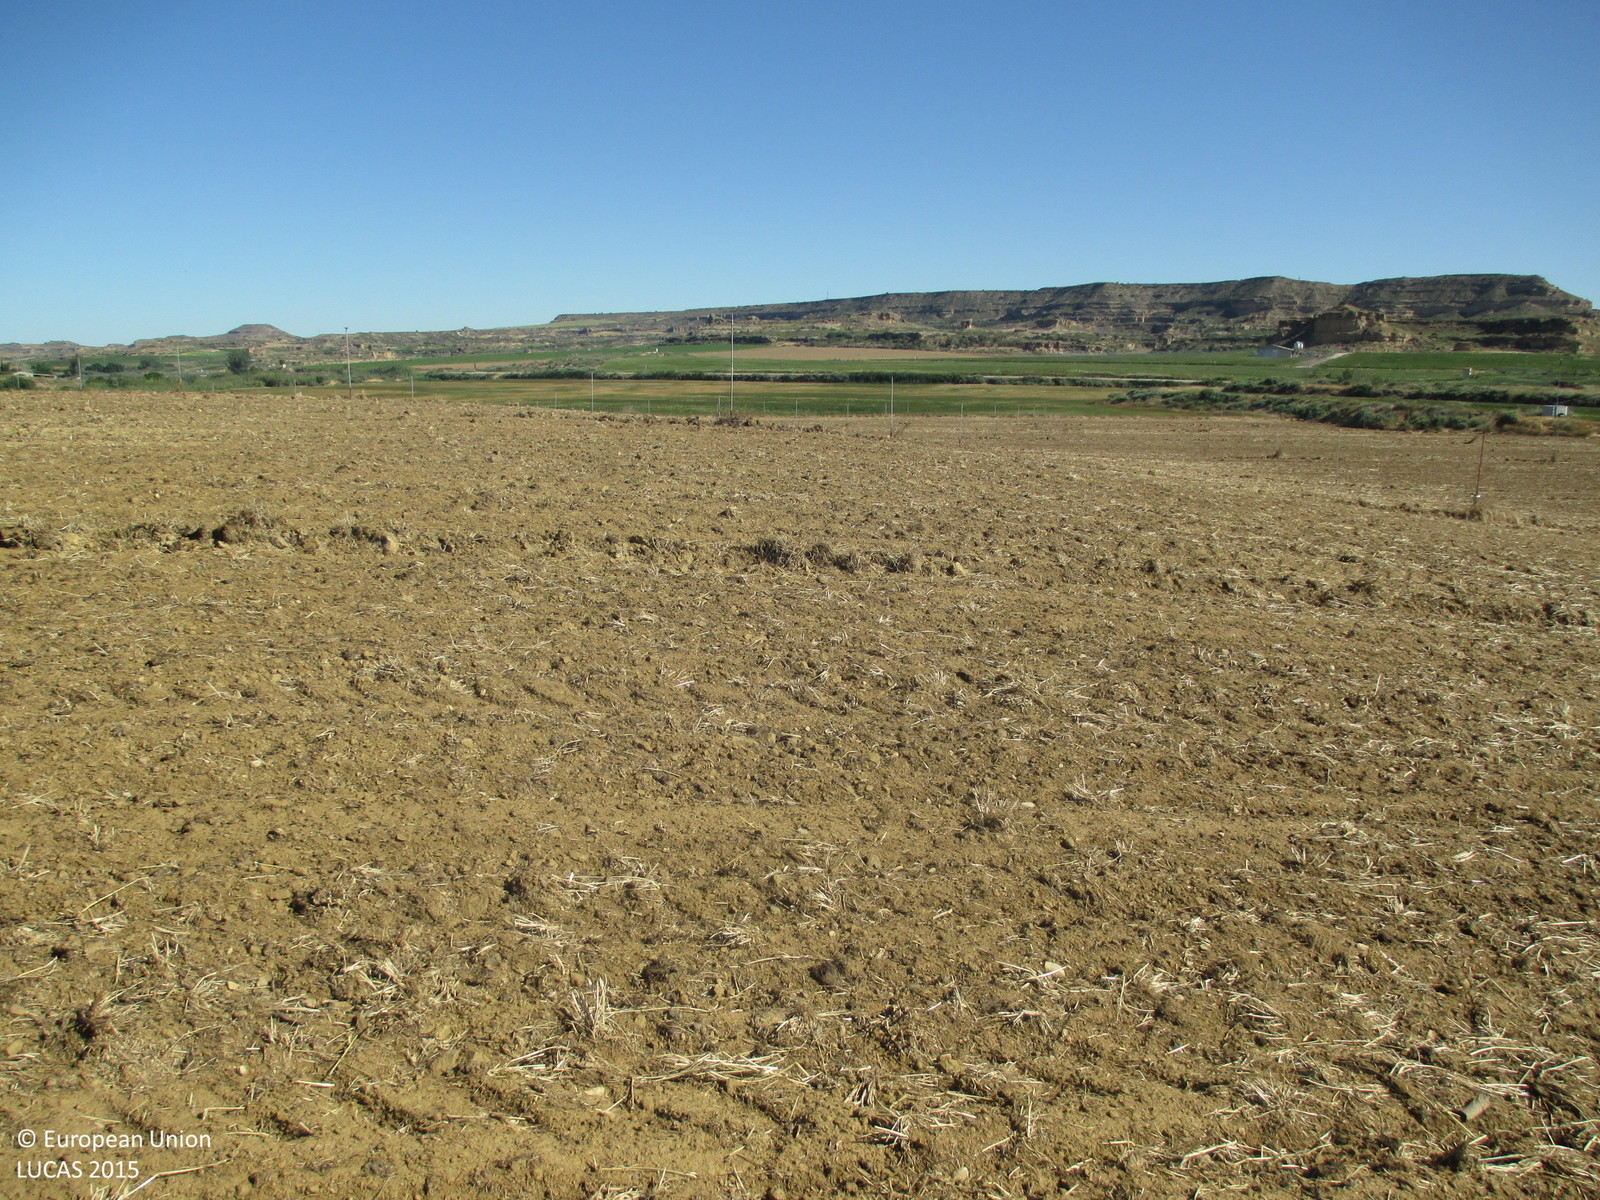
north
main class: Cropland
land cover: Maize
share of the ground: < 10 %
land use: Agriculture (excluding fallow land and kitchen gardens)
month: May
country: ES
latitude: 41.9008
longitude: -0.2049
